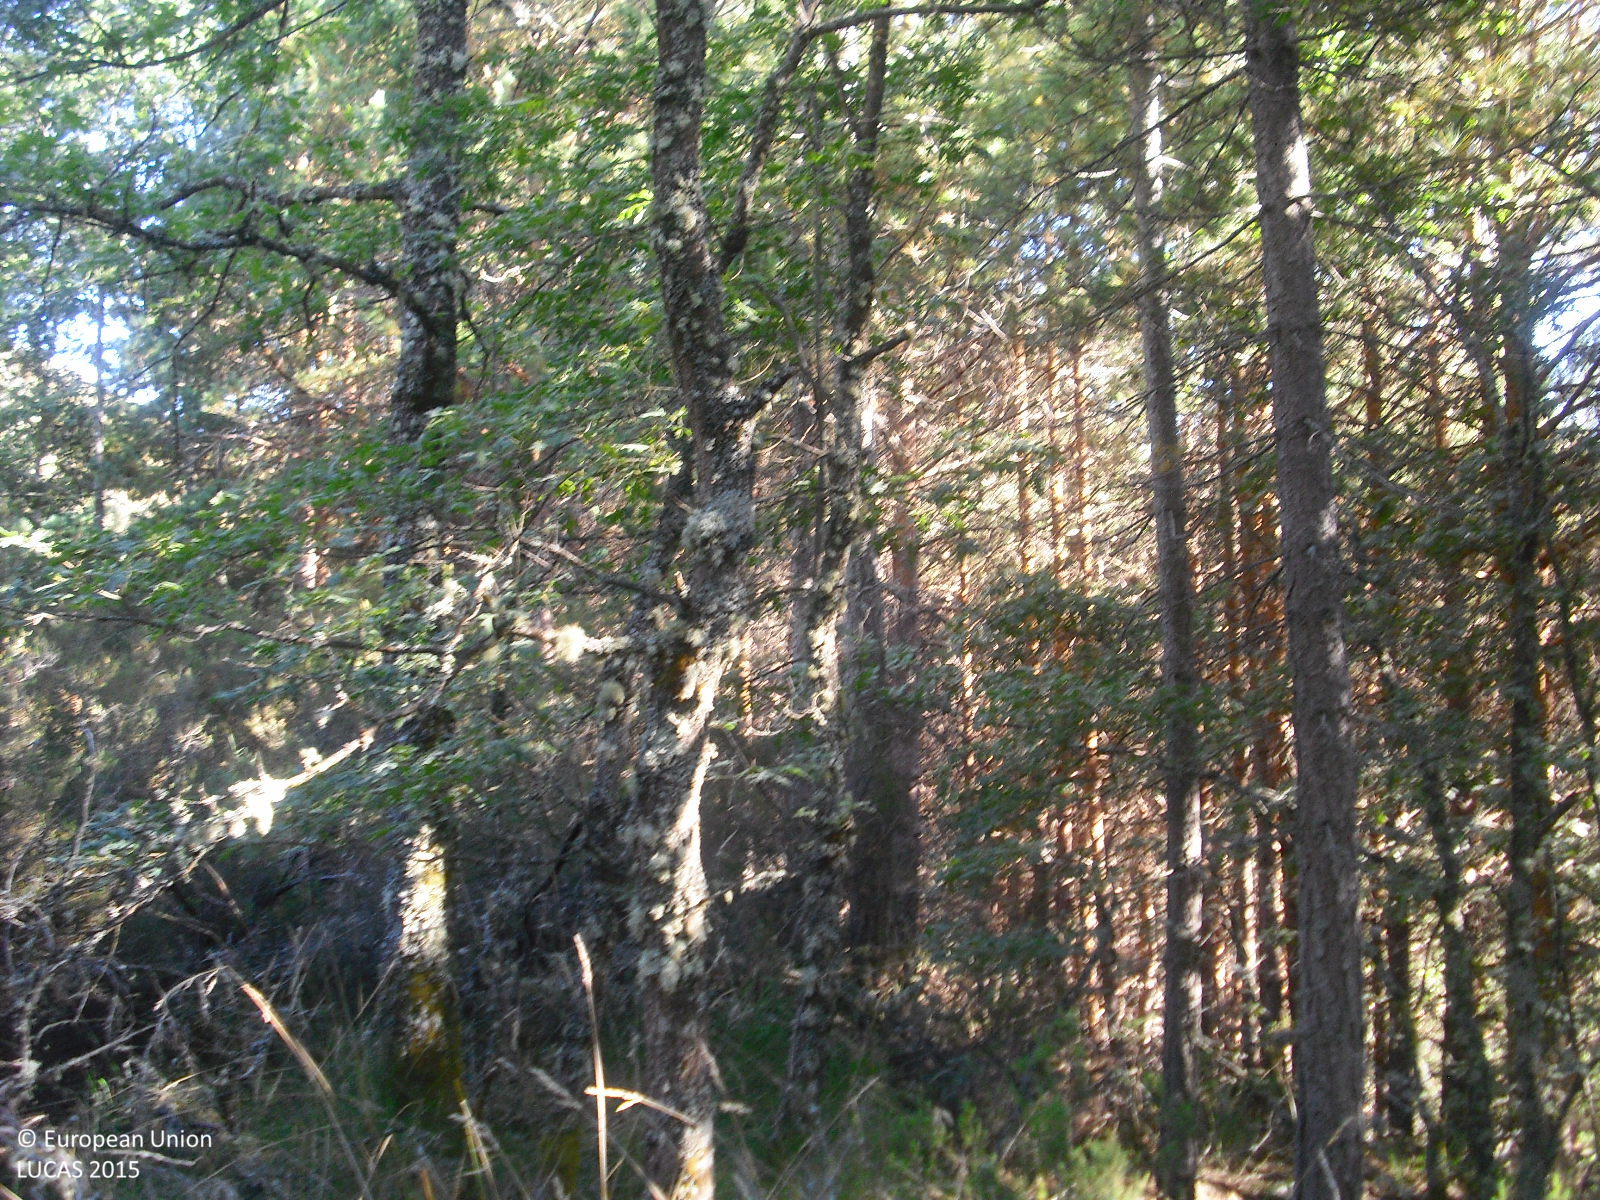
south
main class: Woodland
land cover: Pine dominated mixed woodland
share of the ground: 25 - 50 %
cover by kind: shrubs 60 %, coniferous forest trees 25 %, broadleaved forest trees 15 %
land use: Forestry
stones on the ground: > 50 %
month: August
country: ES
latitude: 42.4926
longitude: -7.0048
